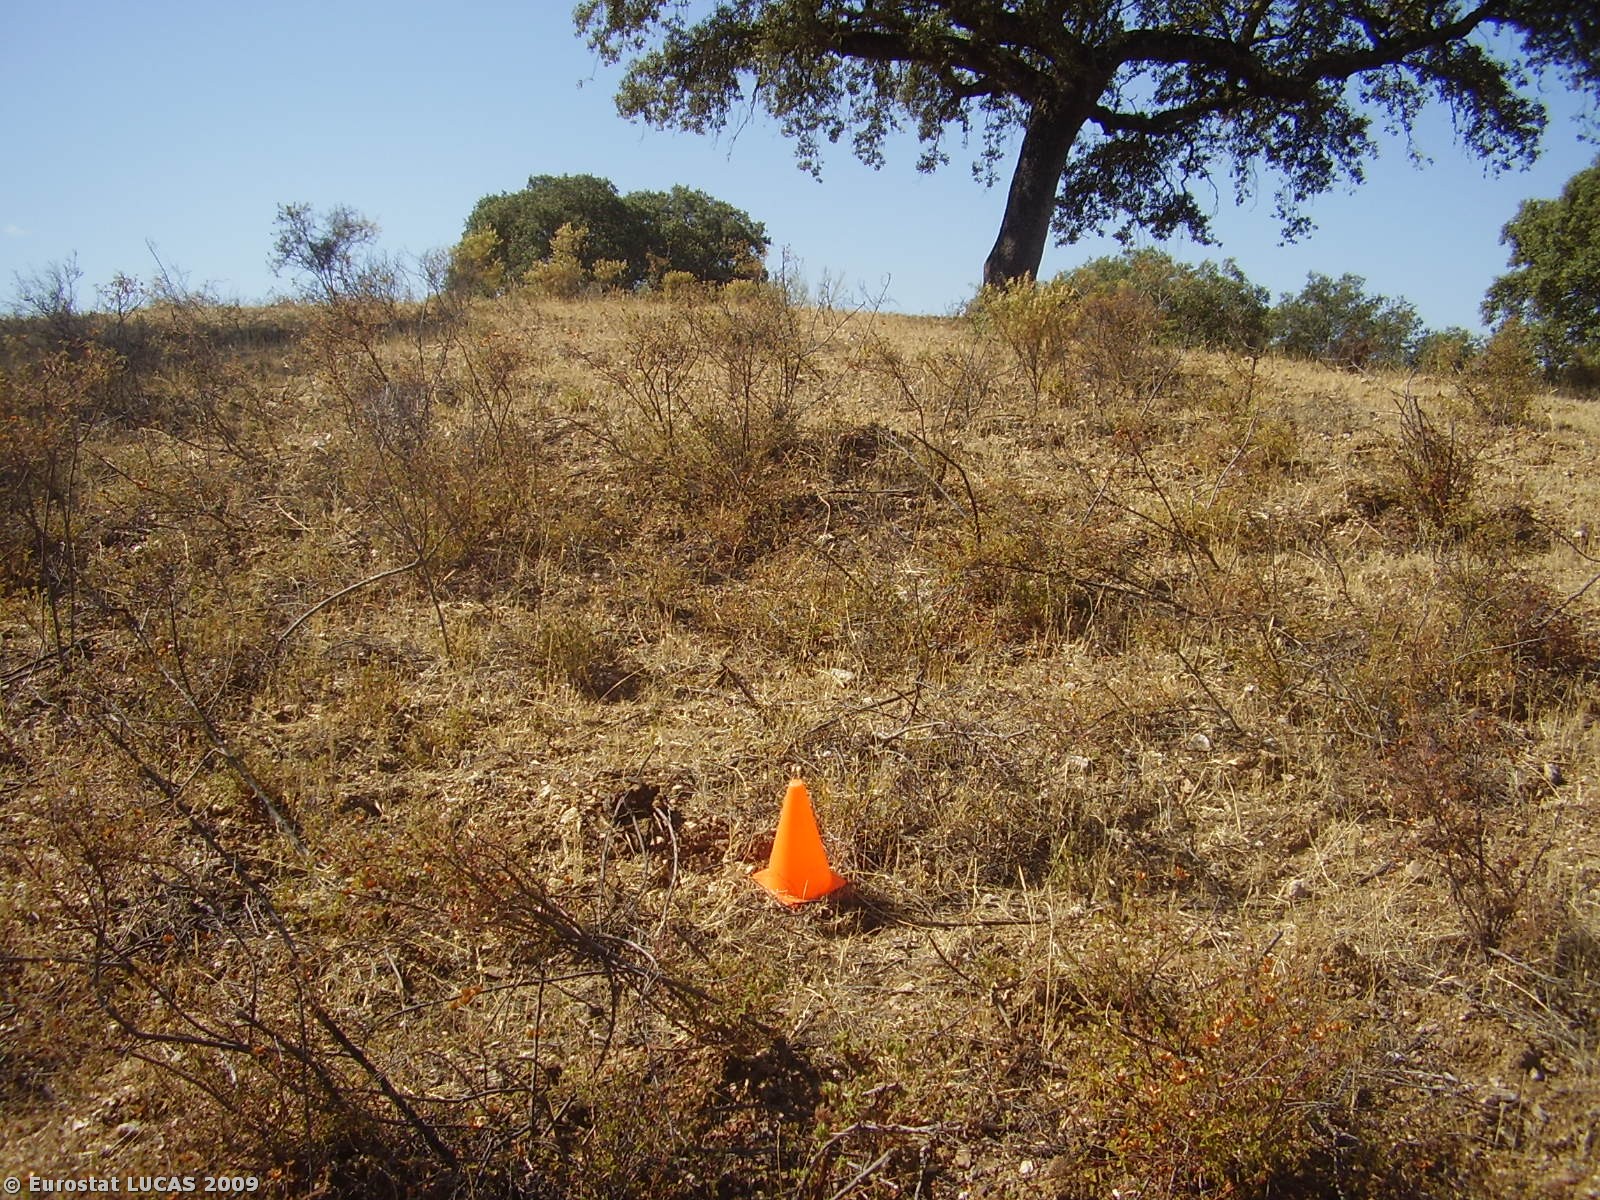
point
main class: Woodland
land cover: Broadleaved woodland
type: broadleaved evergreen forest
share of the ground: 10 - 25 %
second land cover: Grassland with sparse tree/shrub cover
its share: > 75 %
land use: Forestry
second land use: Fallow land
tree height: > 5 m
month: August
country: PT
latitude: 38.1651
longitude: -7.5899
